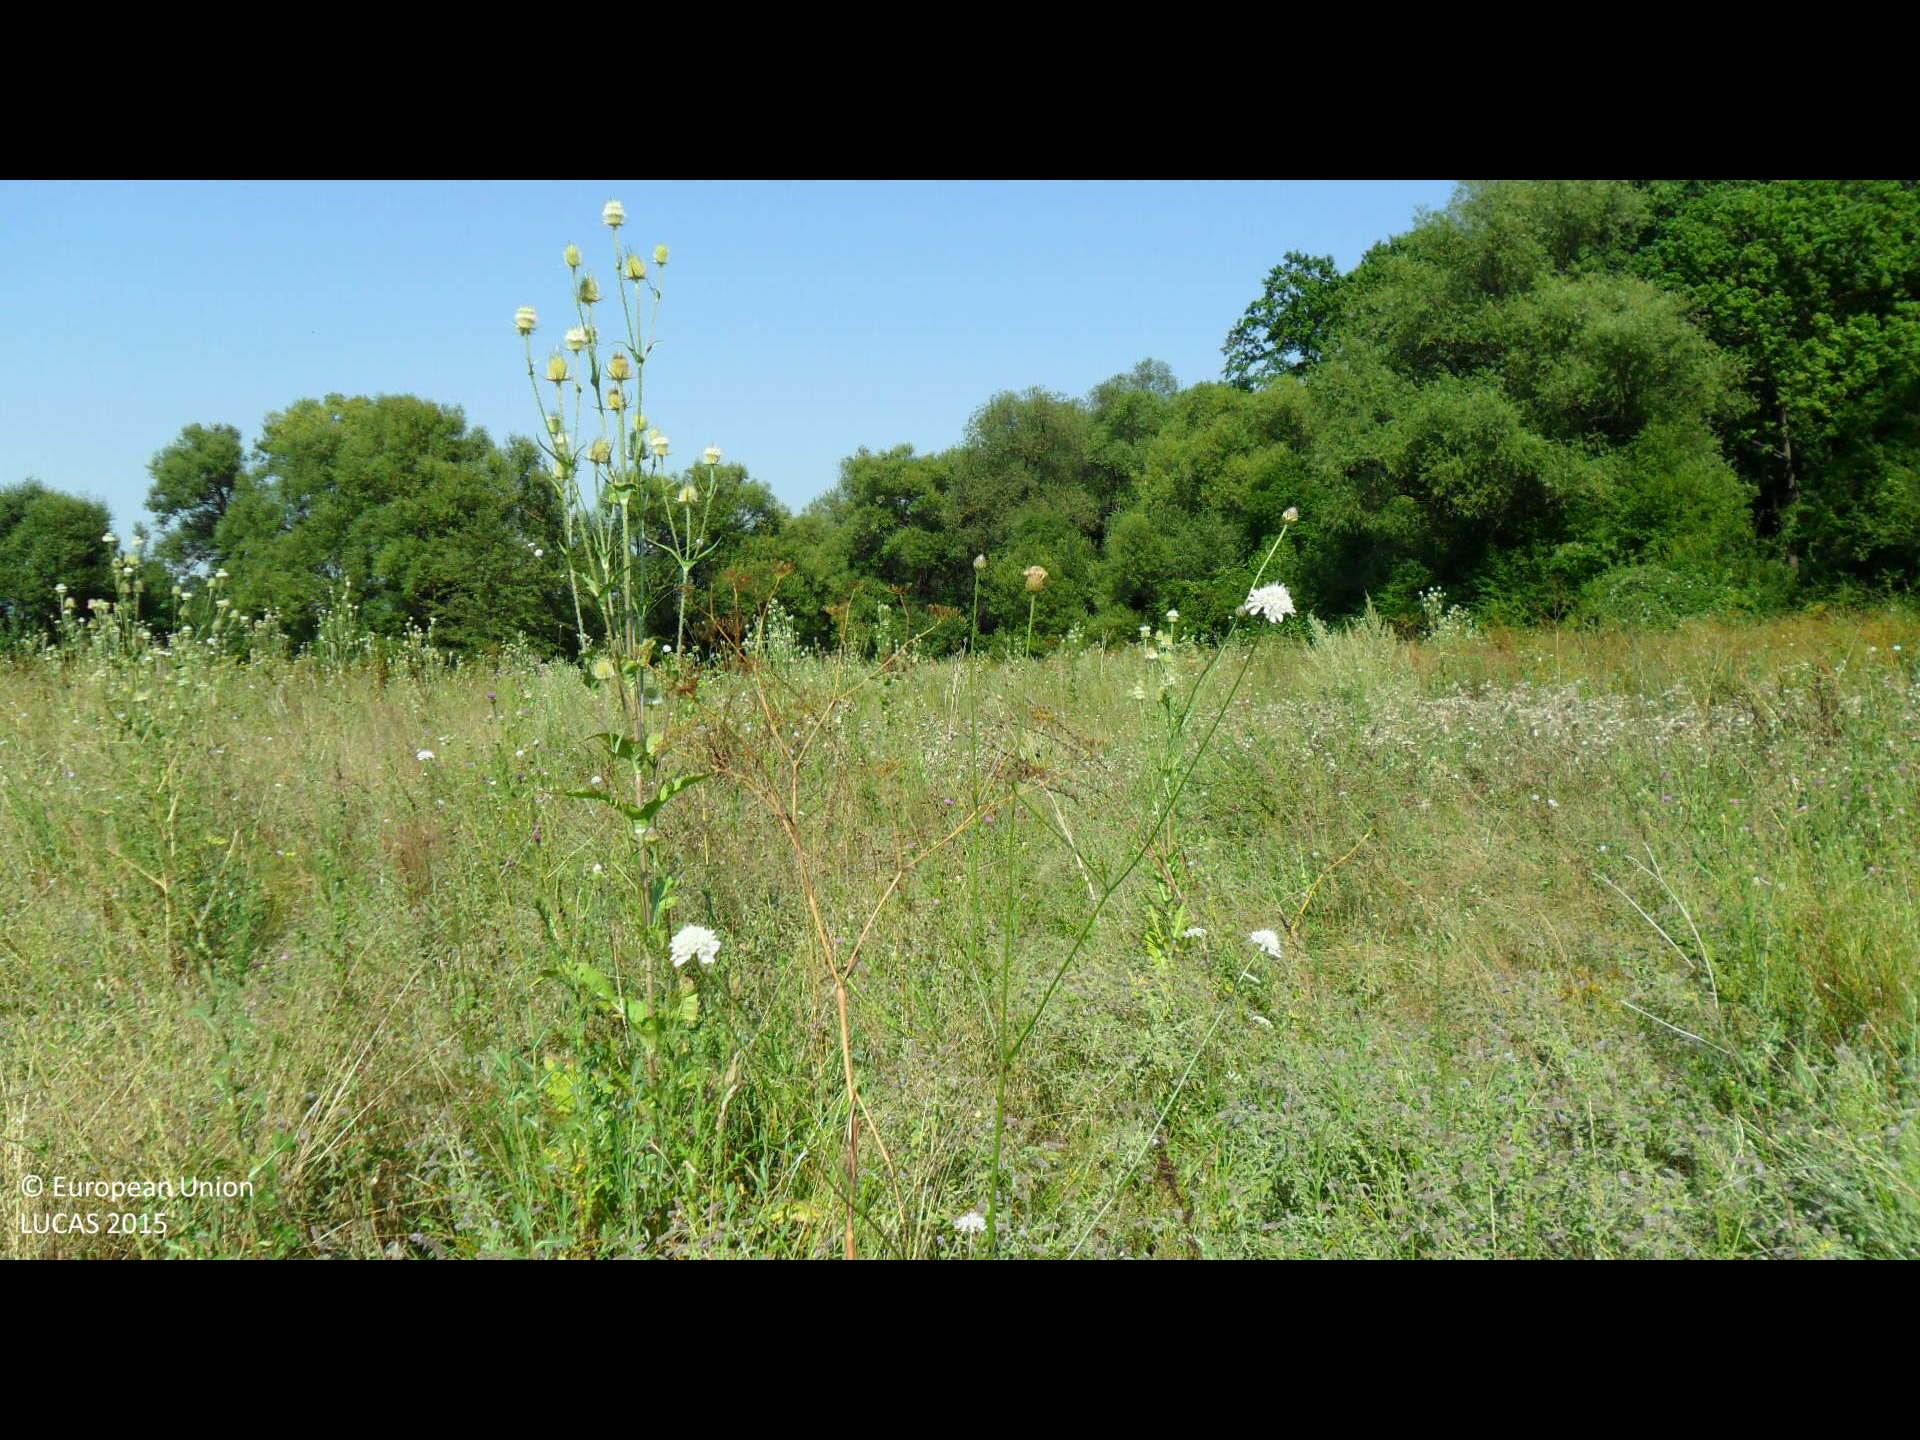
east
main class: Grassland
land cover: Grassland without tree/shrub cover
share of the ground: > 75 %
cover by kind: herbaceous plants 100 %
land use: Semi-natural and natural areas not in use
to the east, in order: Grassland without tree/shrub cover; Broadleaved woodland; Rivers and streams; Broadleaved woodland
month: August
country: BG
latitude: 43.3049
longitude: 26.2078
